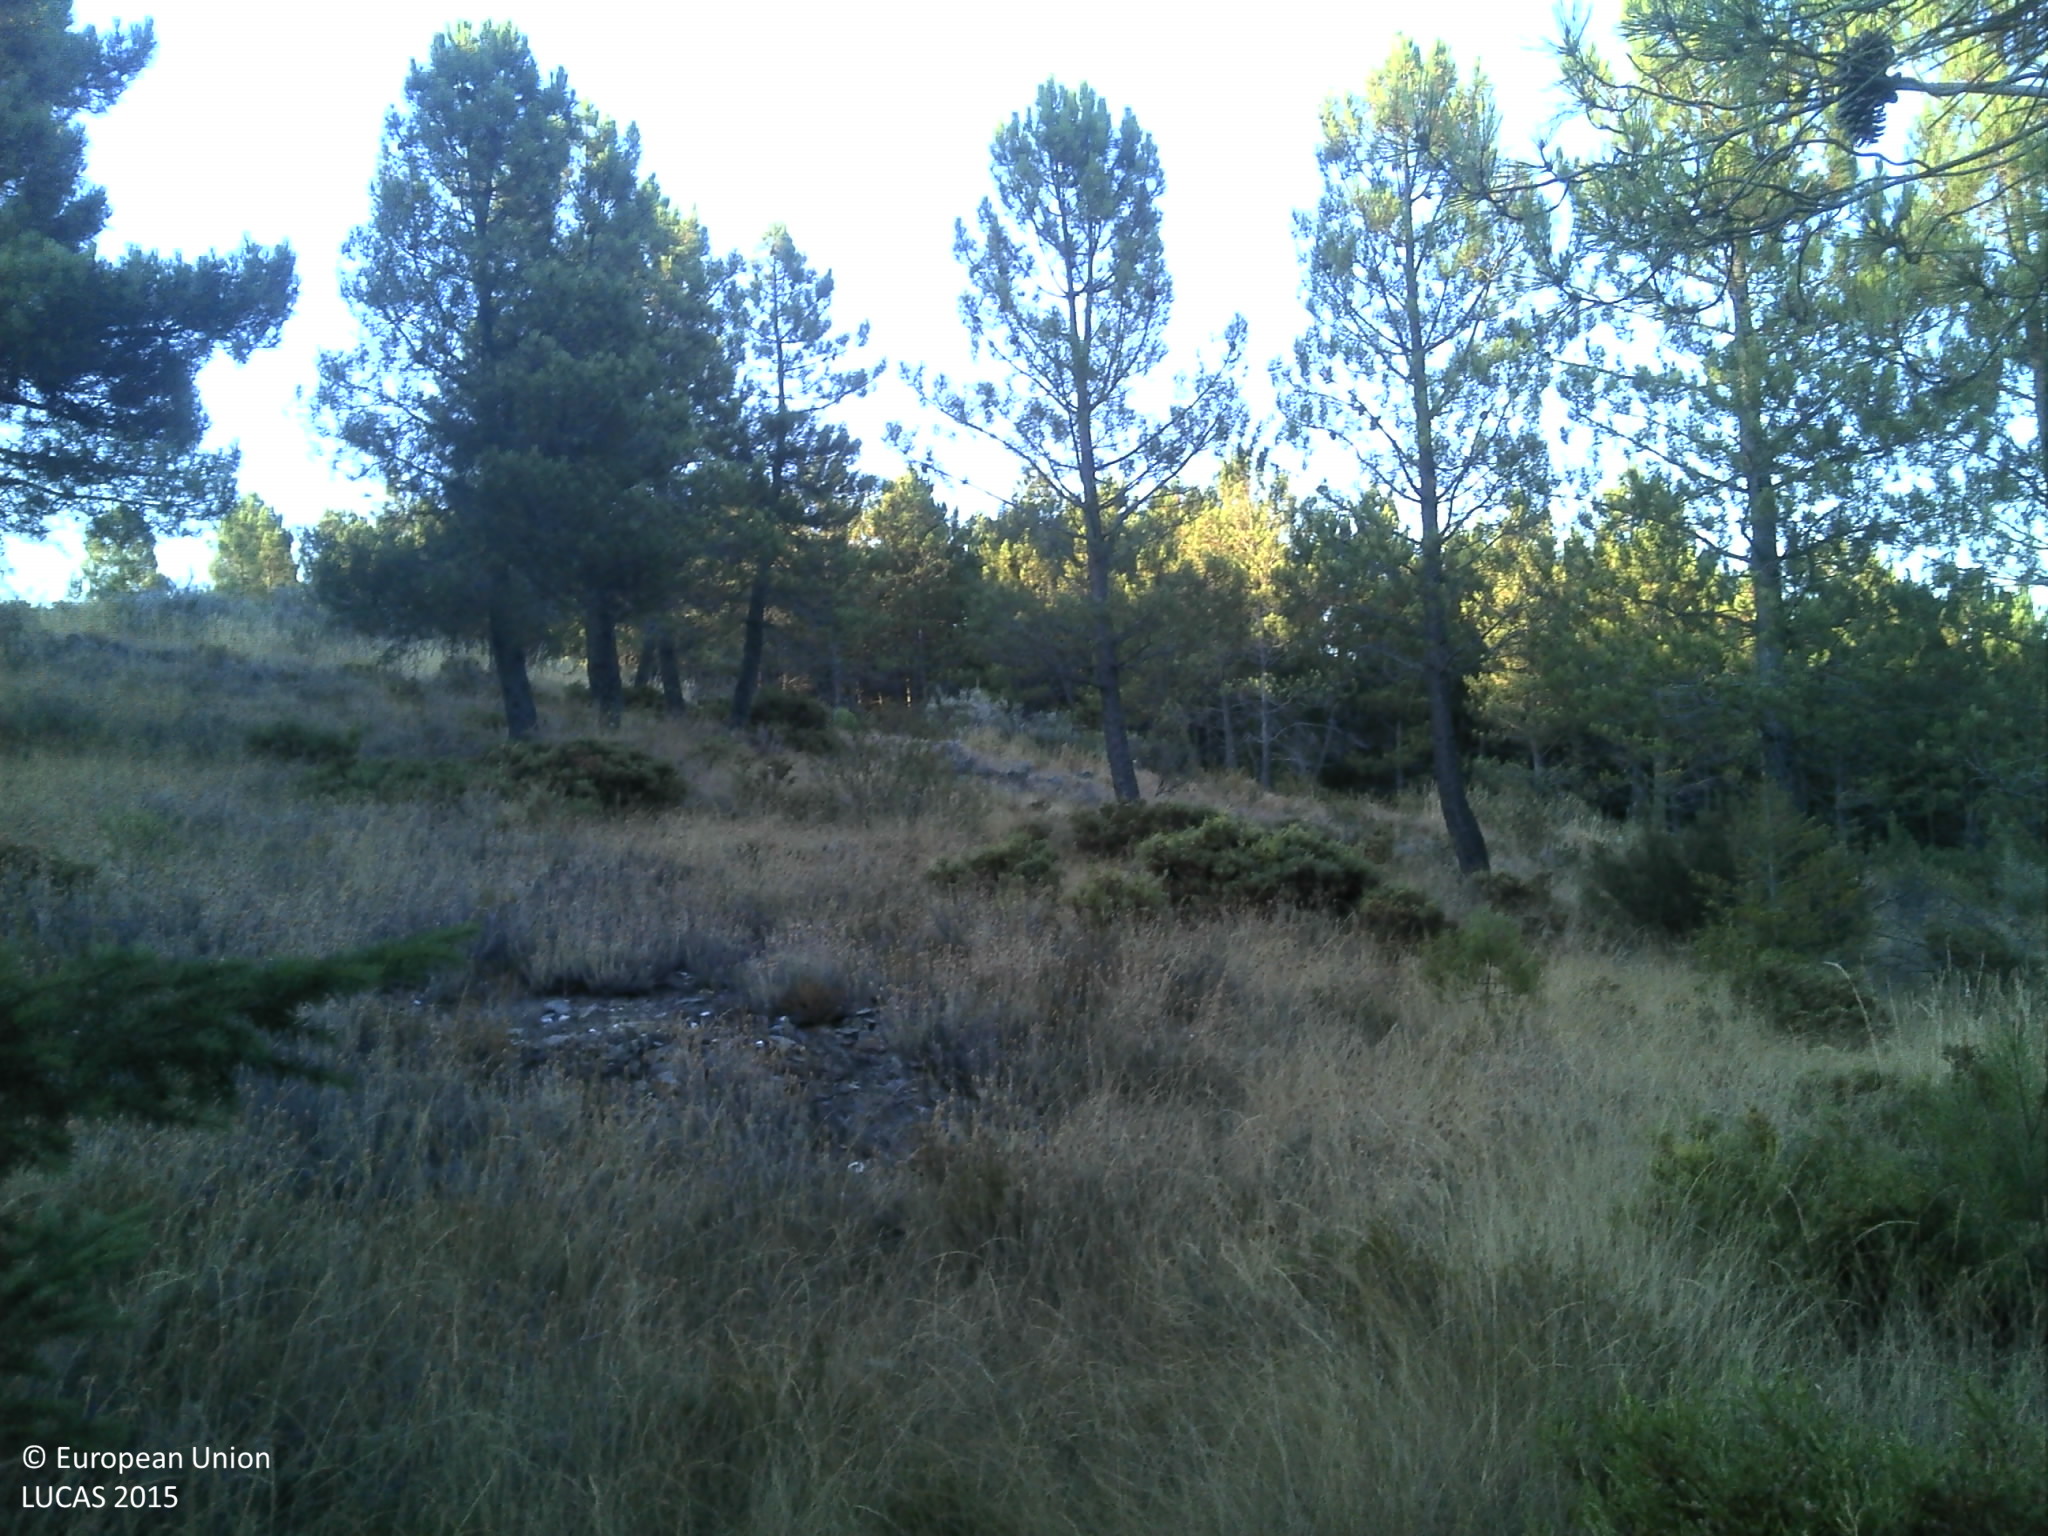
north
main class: Woodland
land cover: Pine dominated coniferous woodland
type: coniferous forest of the mediterranean region
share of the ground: 50 - 75 %
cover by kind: coniferous forest trees 60 %, shrubs 15 %, unconsolidated bare surface 15 %
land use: Forestry
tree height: > 5 m
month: August
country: PT
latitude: 40.4427
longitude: -7.4515
